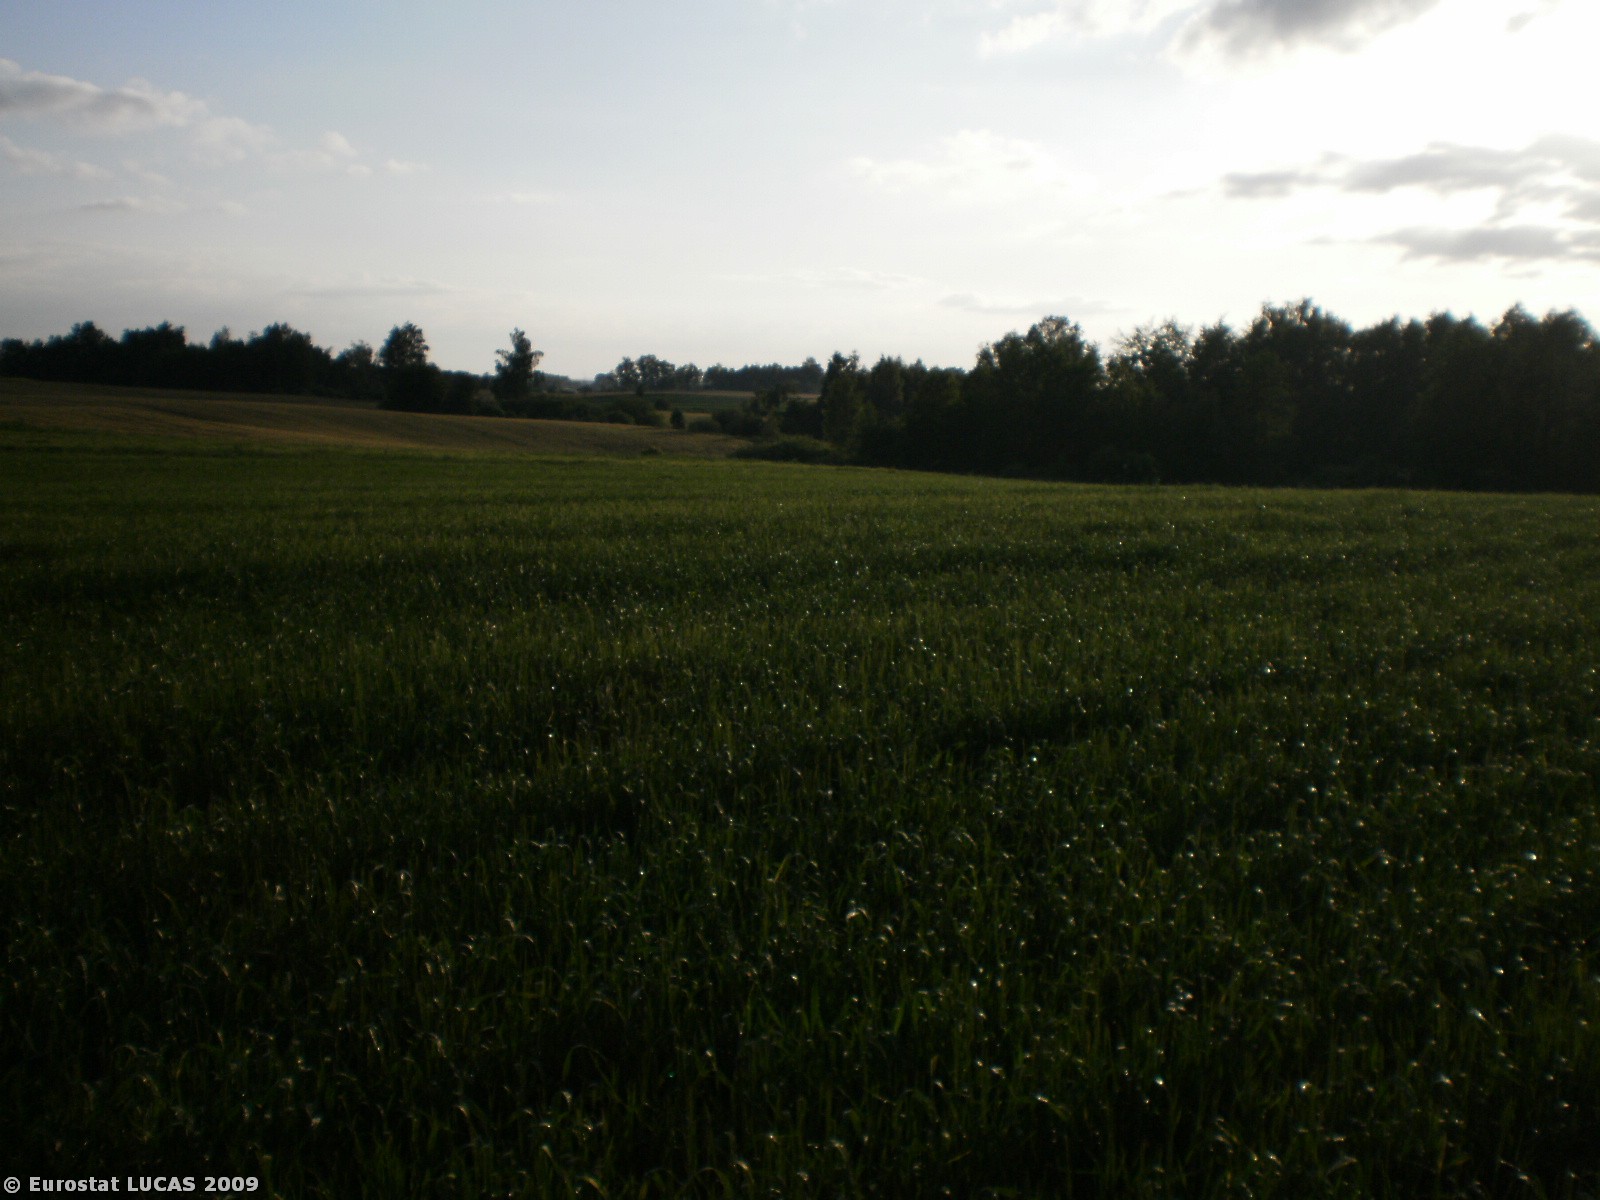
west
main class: Cropland
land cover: Triticale
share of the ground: > 75 %
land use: Agriculture (excluding fallow land and kitchen gardens)
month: June
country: PL
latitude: 53.4917
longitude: 19.8118
